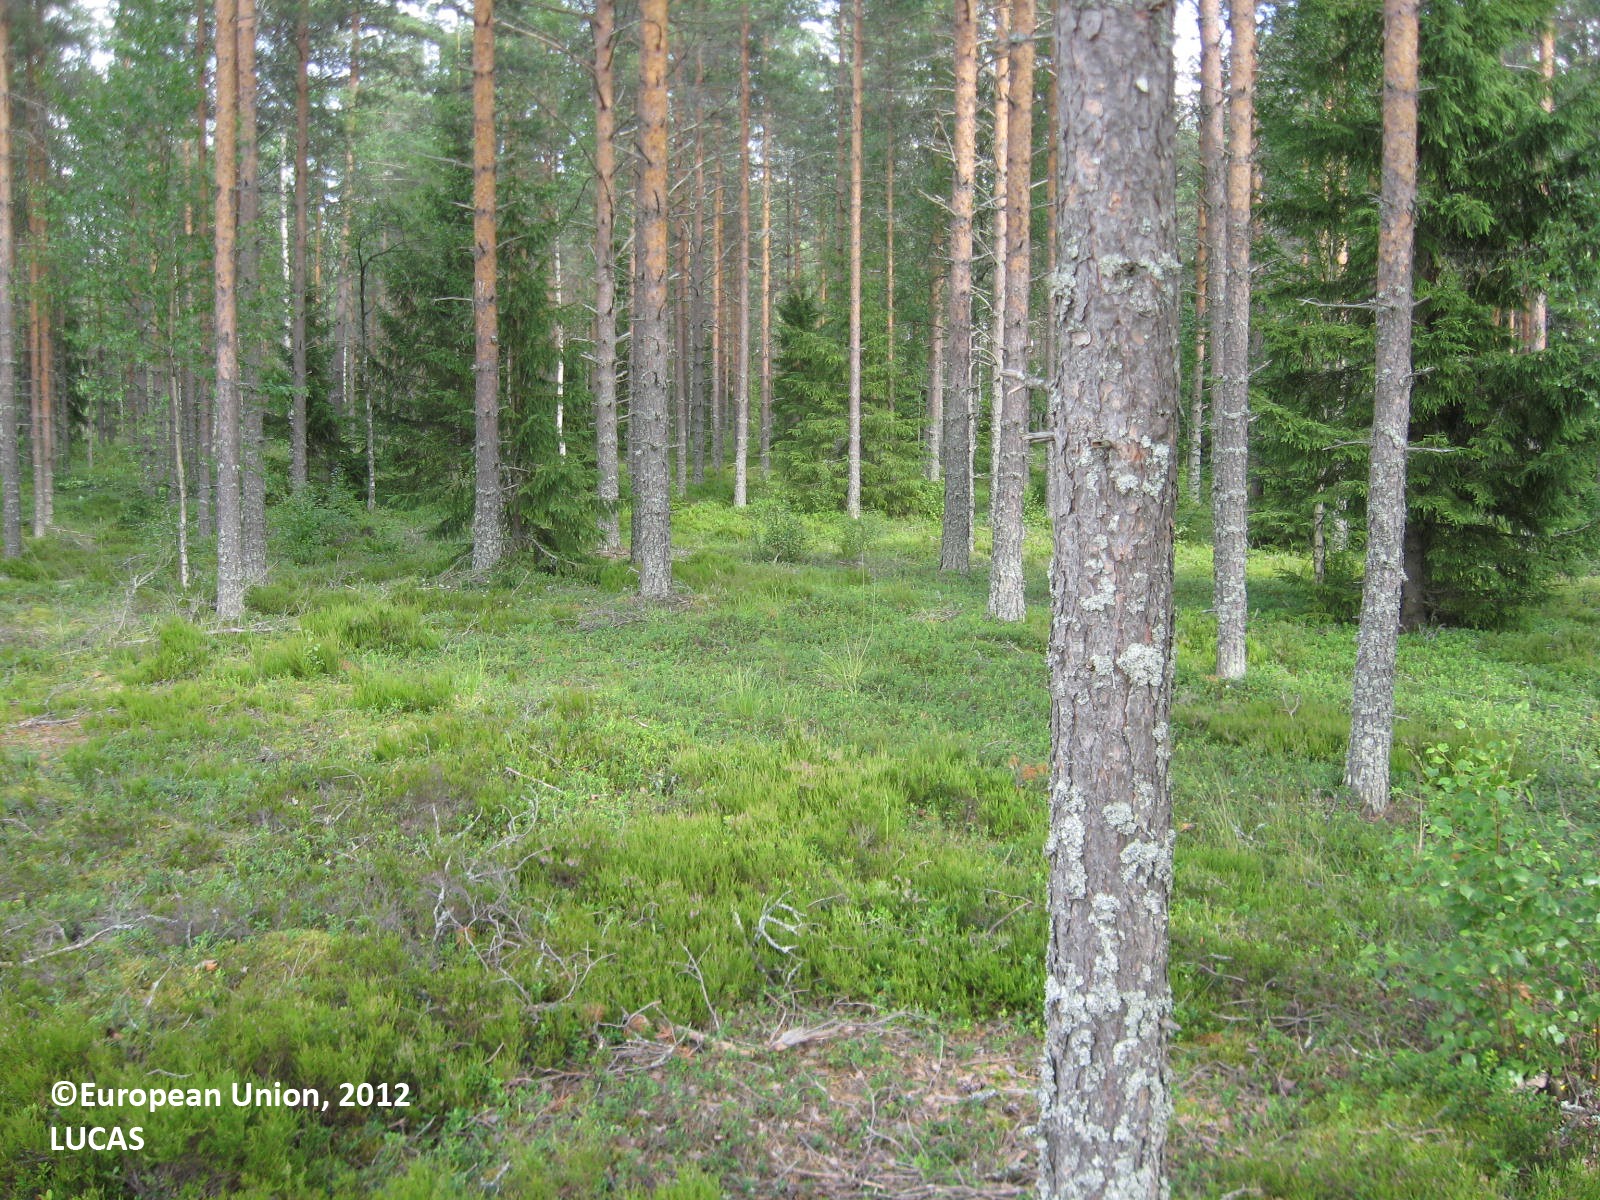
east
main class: Woodland
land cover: Pine dominated coniferous woodland
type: boreal forest
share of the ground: > 75 %
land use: Forestry
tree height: > 5 m
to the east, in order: Pine dominated coniferous woodland; Ditches and canals; Pine dominated coniferous woodland
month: July
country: FI
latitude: 62.1798
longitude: 22.2903
